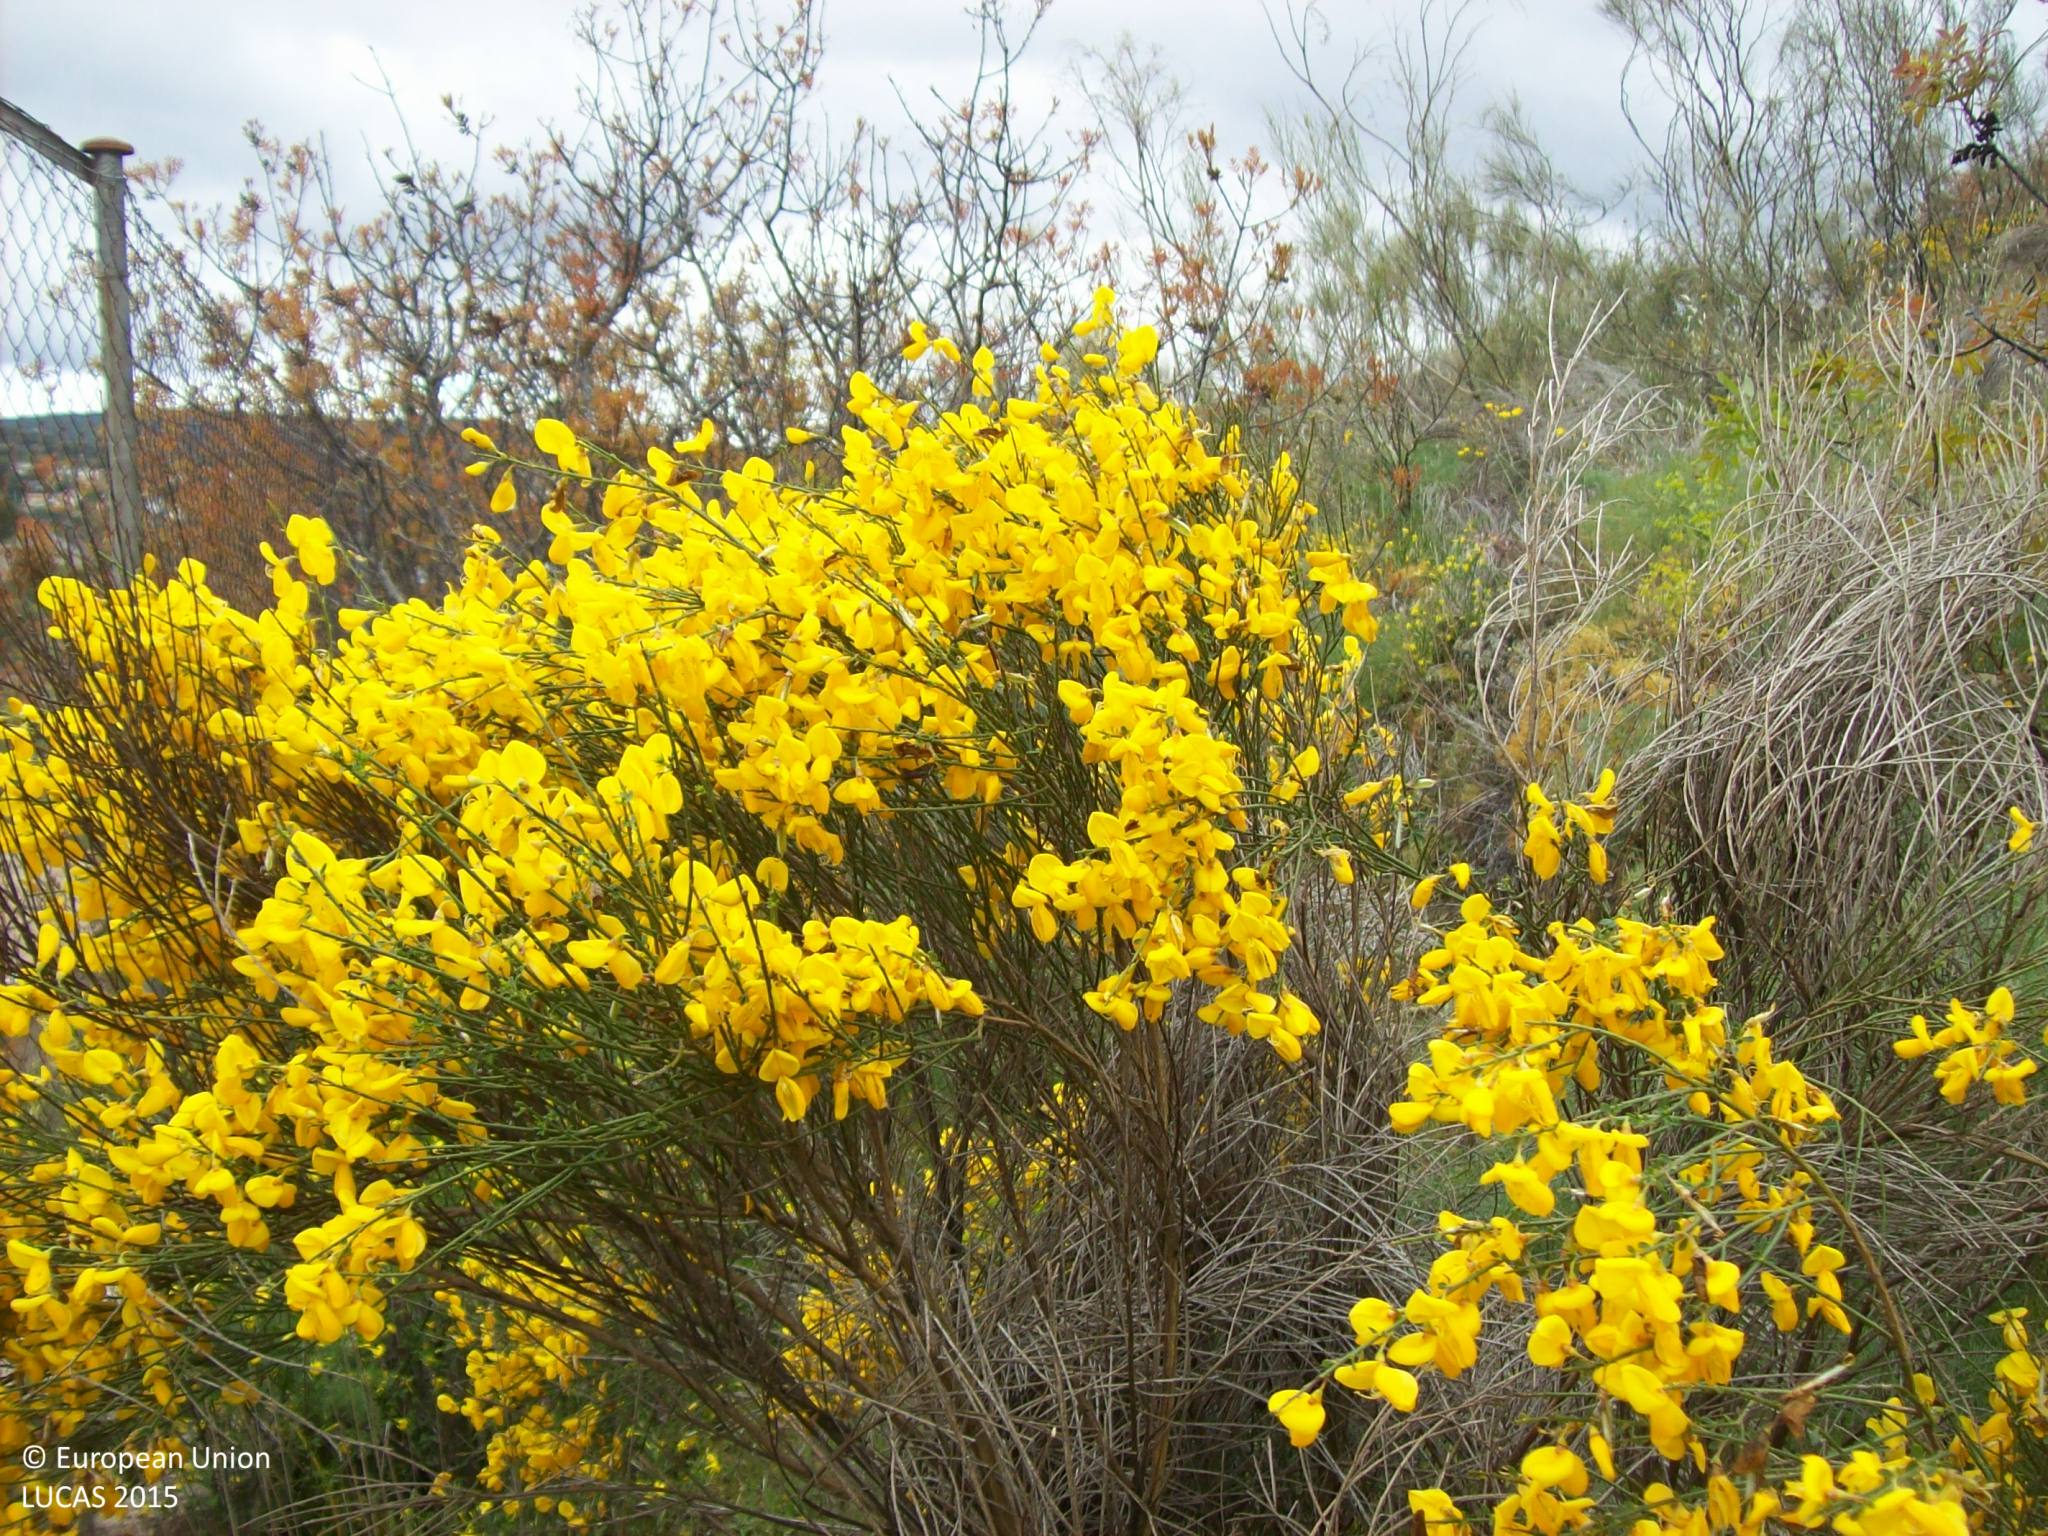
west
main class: Shrubland
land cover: Shrubland with sparse tree cover
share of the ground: 25 - 50 %
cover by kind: shrubs 30 %, herbaceous plants 30 %, consolidated bare surface 30 %, broadleaved forest trees 5 %
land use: Semi-natural and natural areas not in use
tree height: < 5 m
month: April
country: ES
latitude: 40.4997
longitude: -4.4090
